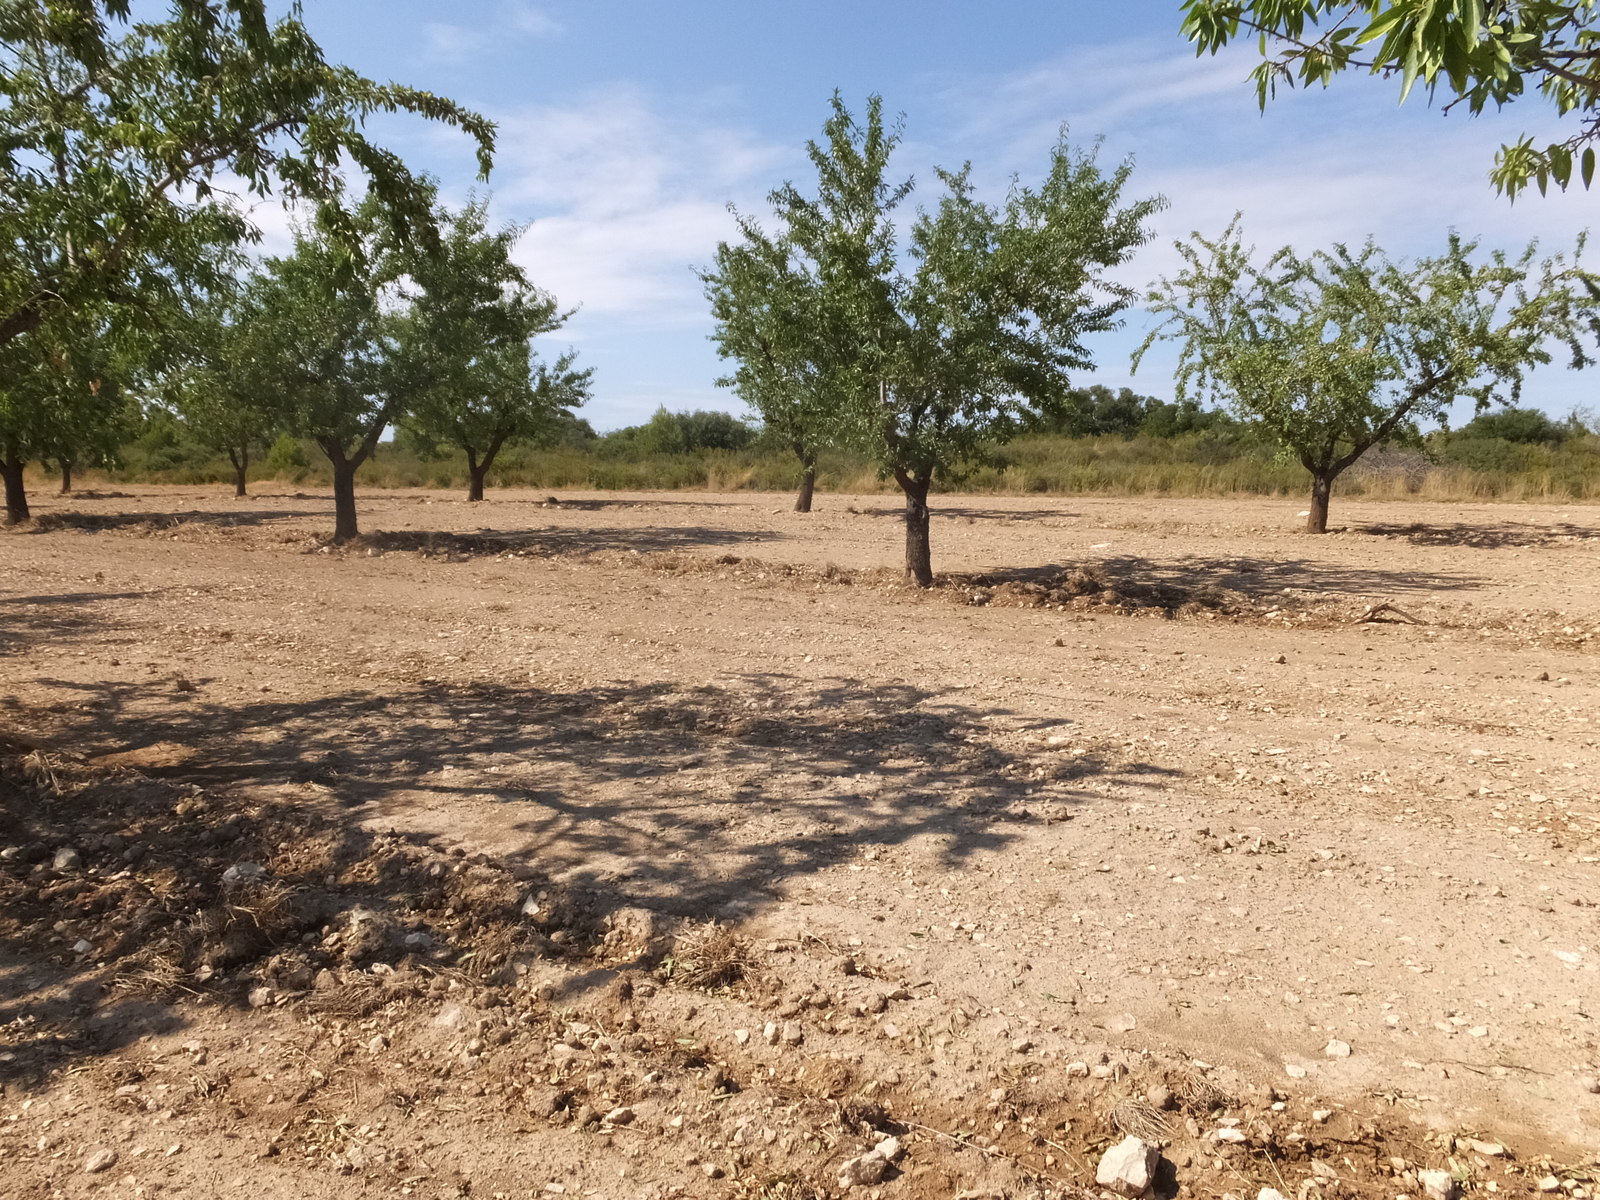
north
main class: Cropland
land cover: Nuts trees
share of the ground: > 75 %
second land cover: Other bare soil
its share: > 75 %
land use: Agriculture (excluding fallow land and kitchen gardens)
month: July
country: ES
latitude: 41.1503
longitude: 0.1110
